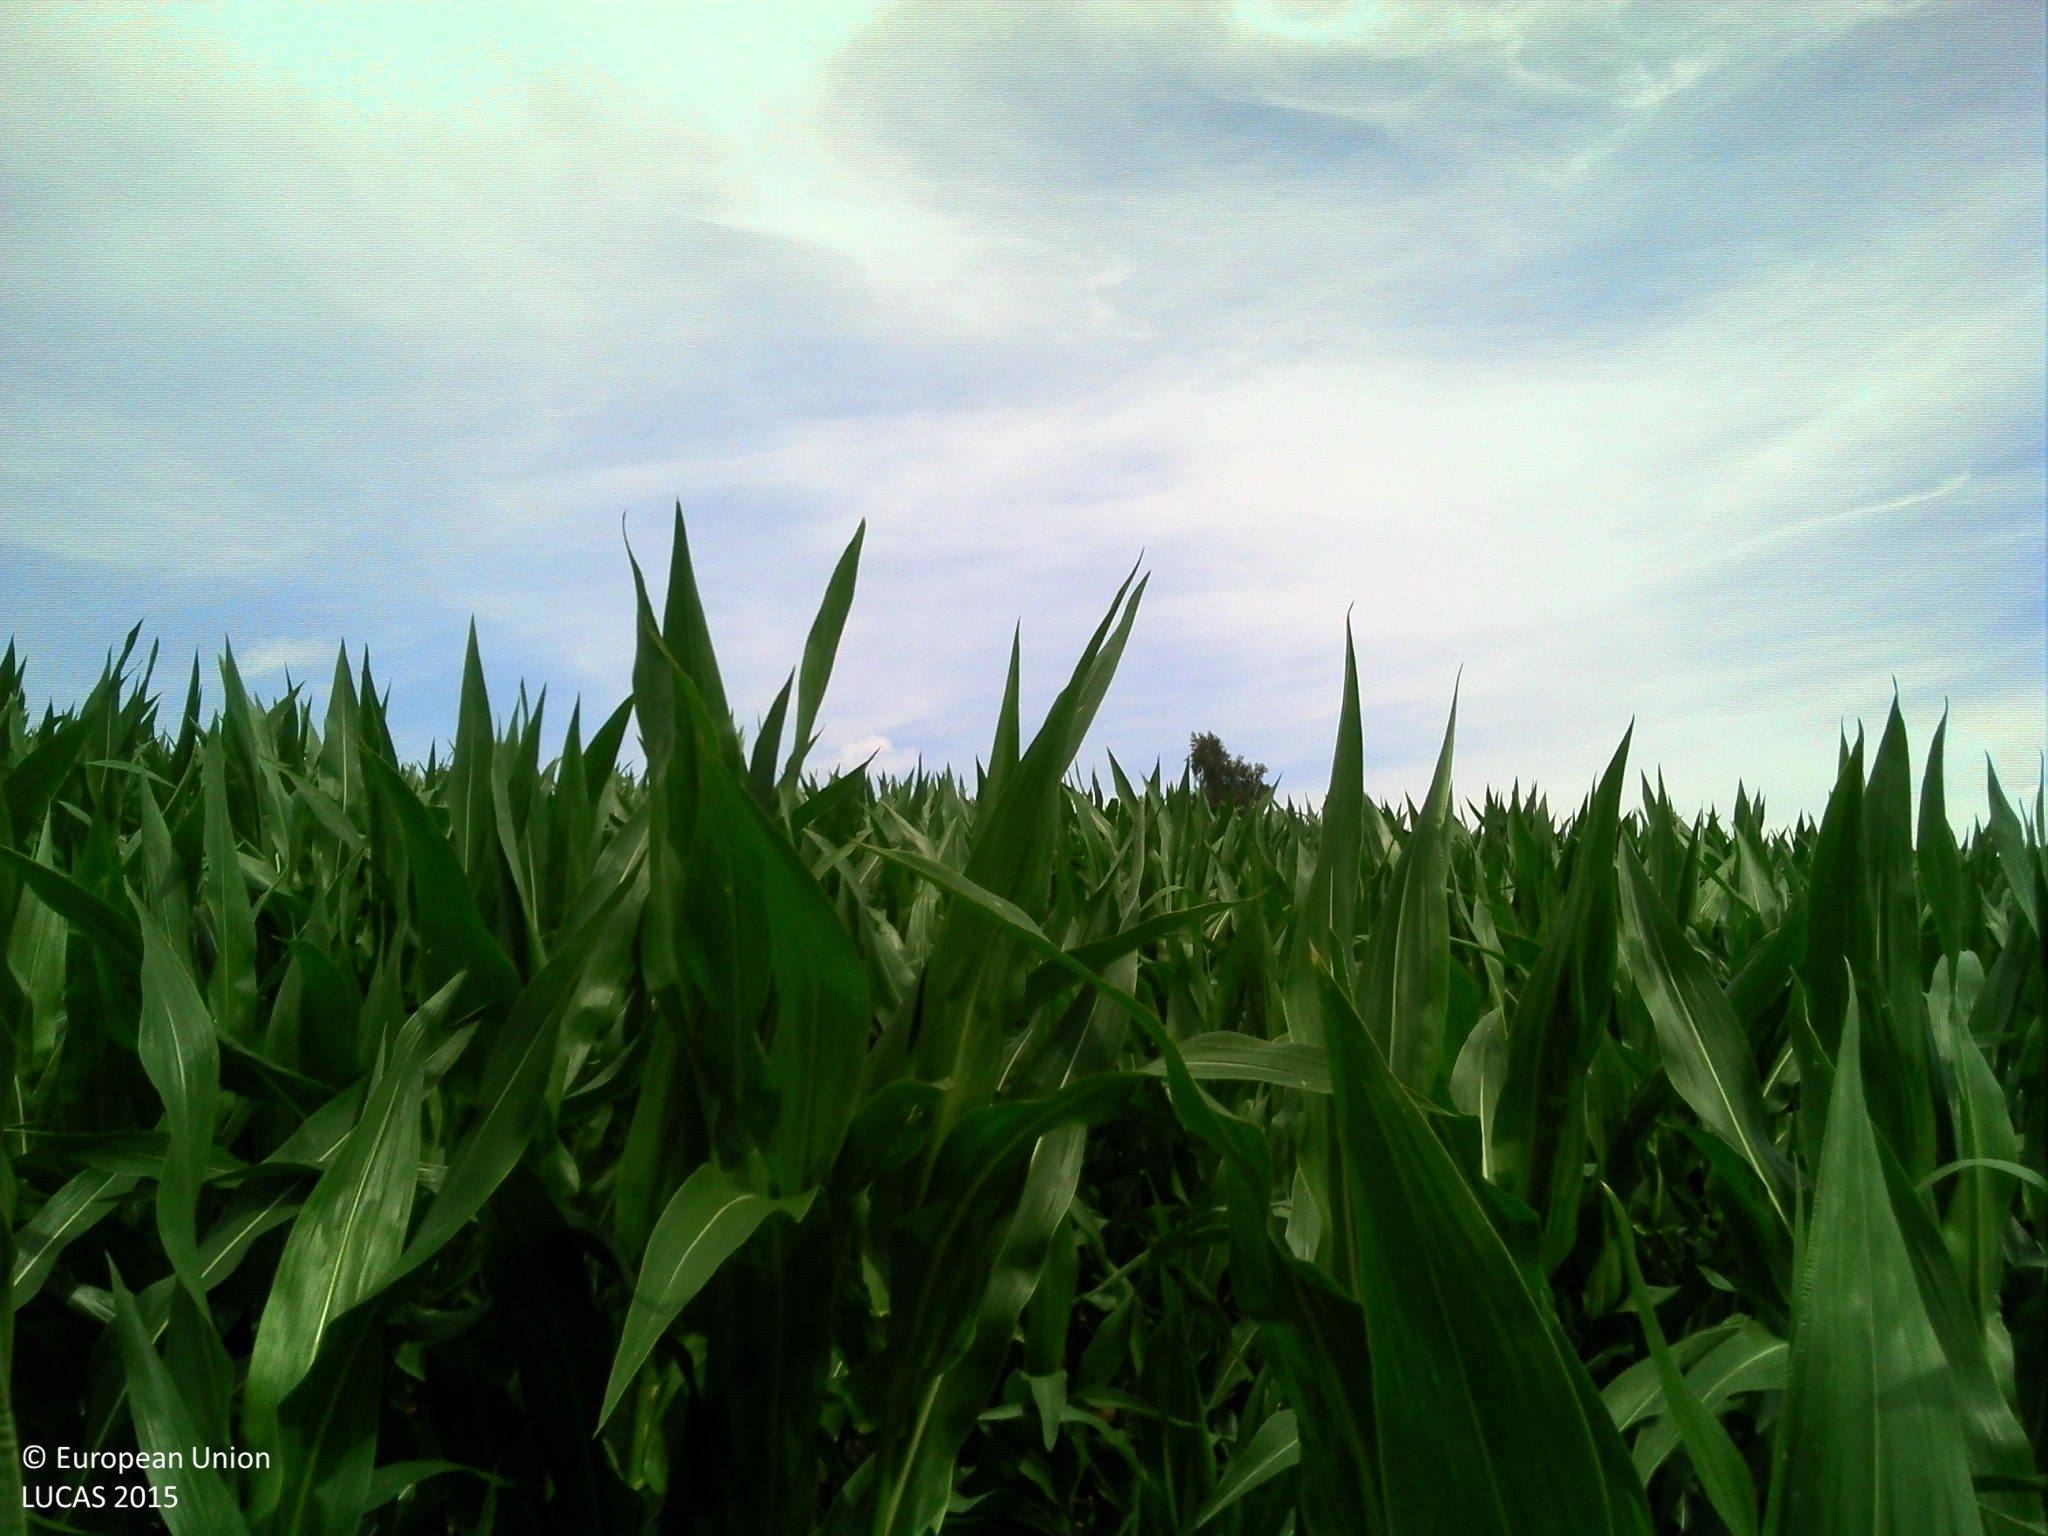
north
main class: Cropland
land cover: Maize
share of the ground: > 75 %
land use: Agriculture (excluding fallow land and kitchen gardens)
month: July
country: FR
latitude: 44.7961
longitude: 2.4036
